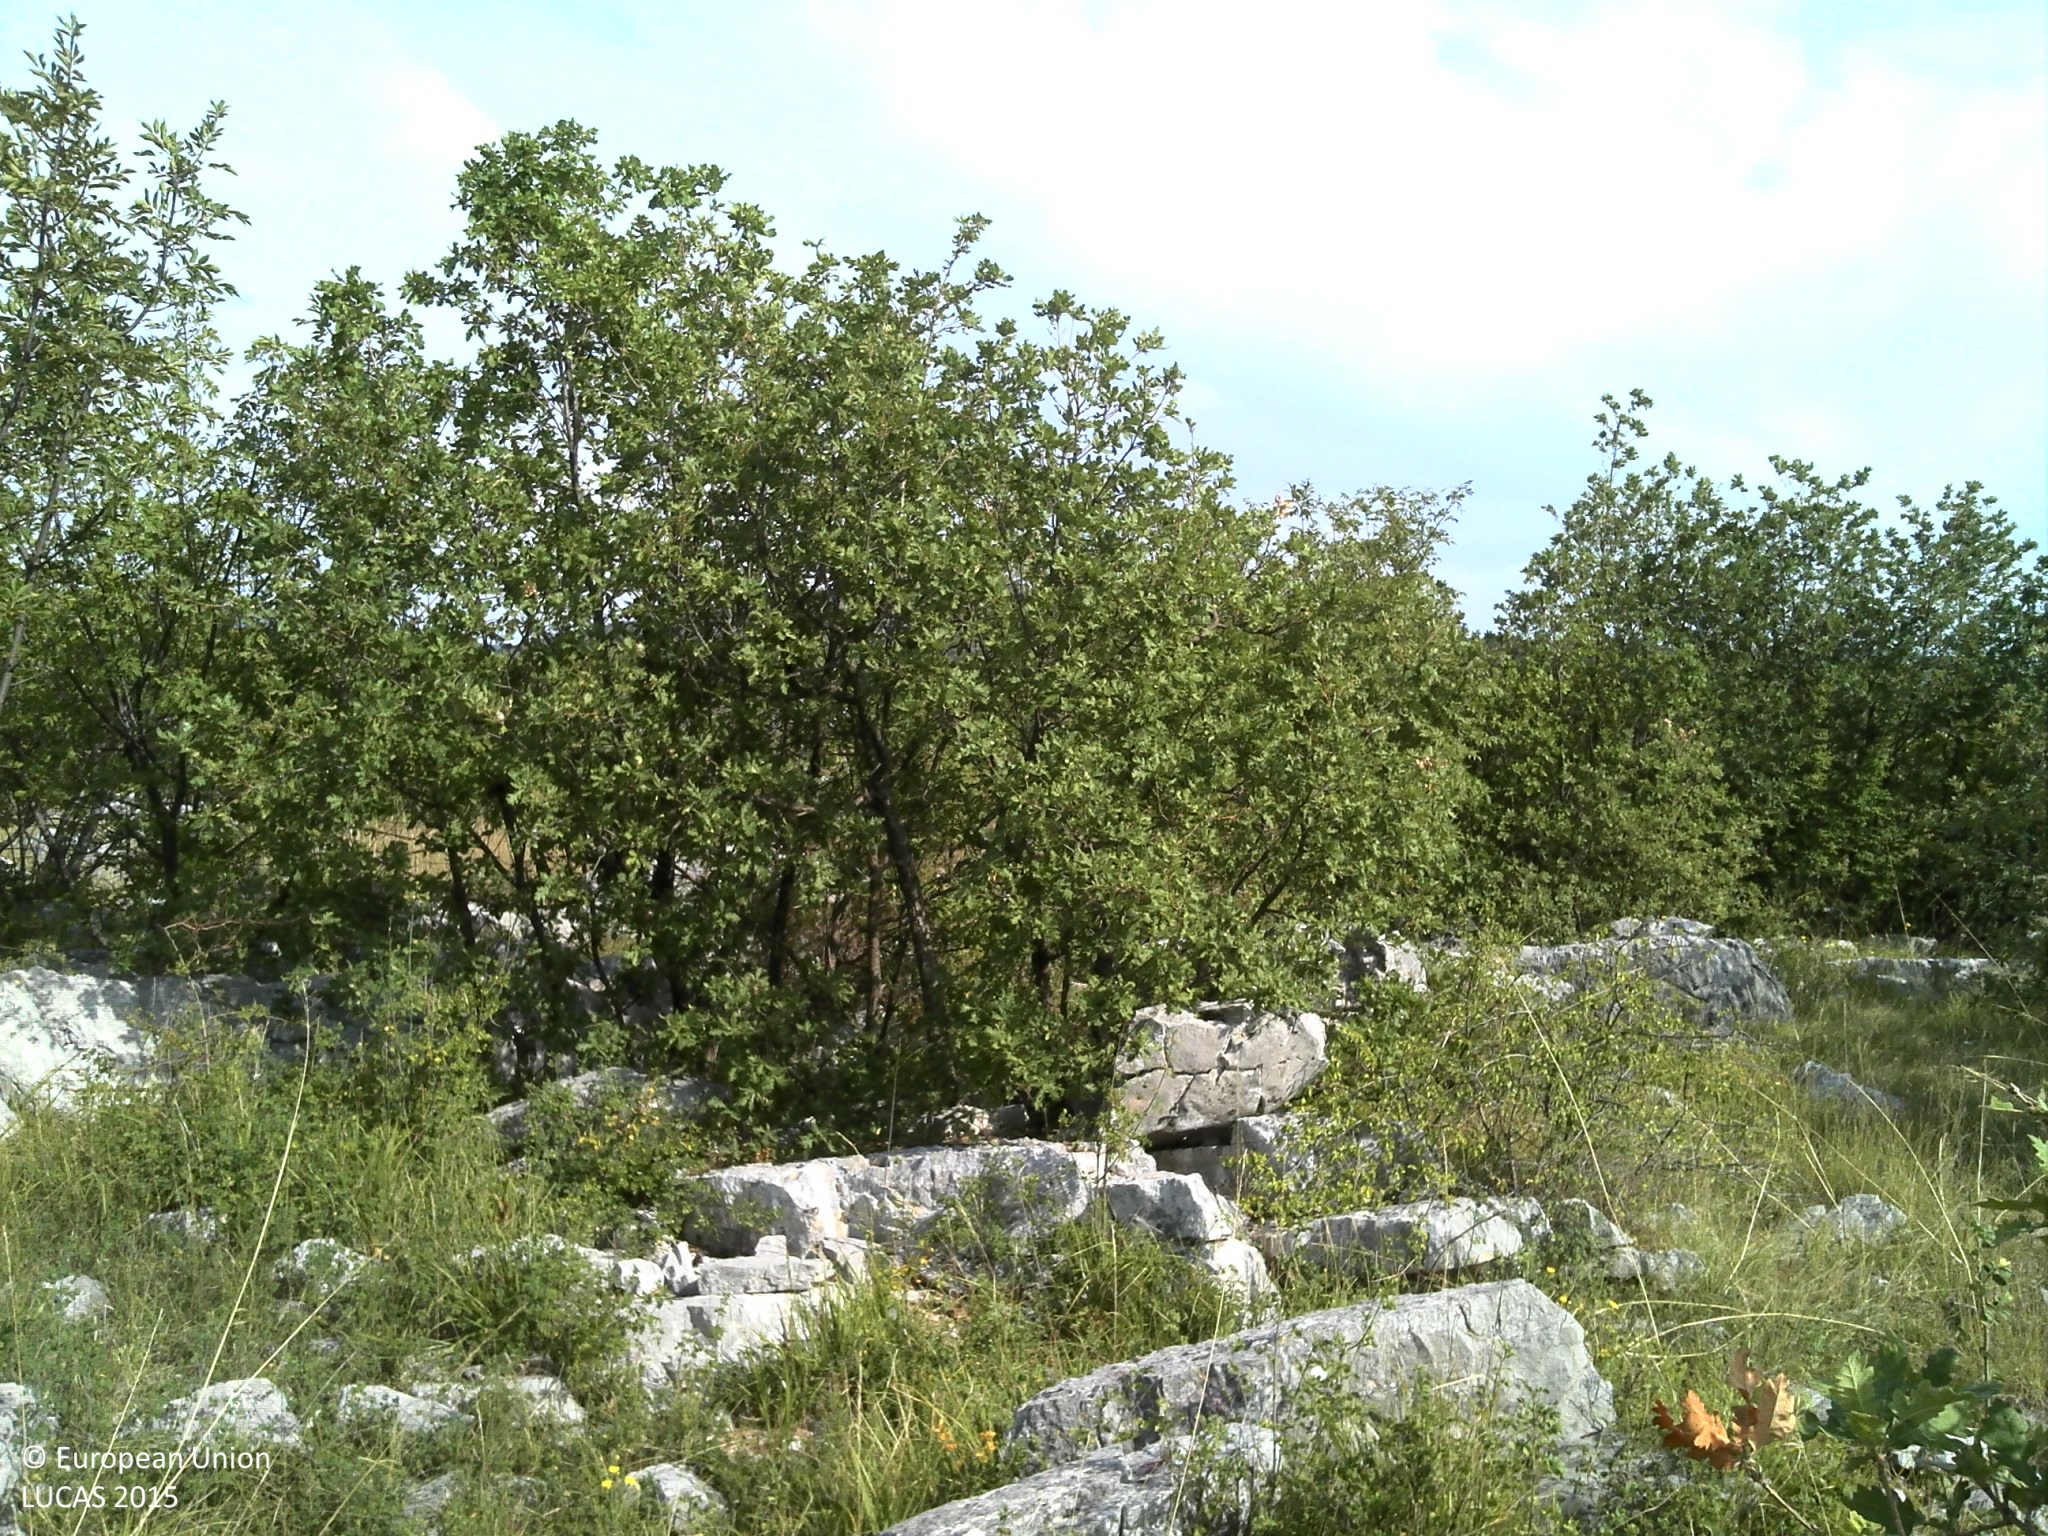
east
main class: Shrubland
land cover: Shrubland with sparse tree cover
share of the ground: 25 - 50 %
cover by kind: herbaceous plants 40 %, shrubs 25 %, consolidated bare surface 20 %, unconsolidated bare surface 10 %, broadleaved forest trees 5 %
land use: Semi-natural and natural areas not in use
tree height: < 5 m
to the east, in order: Shrubland with sparse tree cover
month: September
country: HR
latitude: 43.8516
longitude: 16.2990
